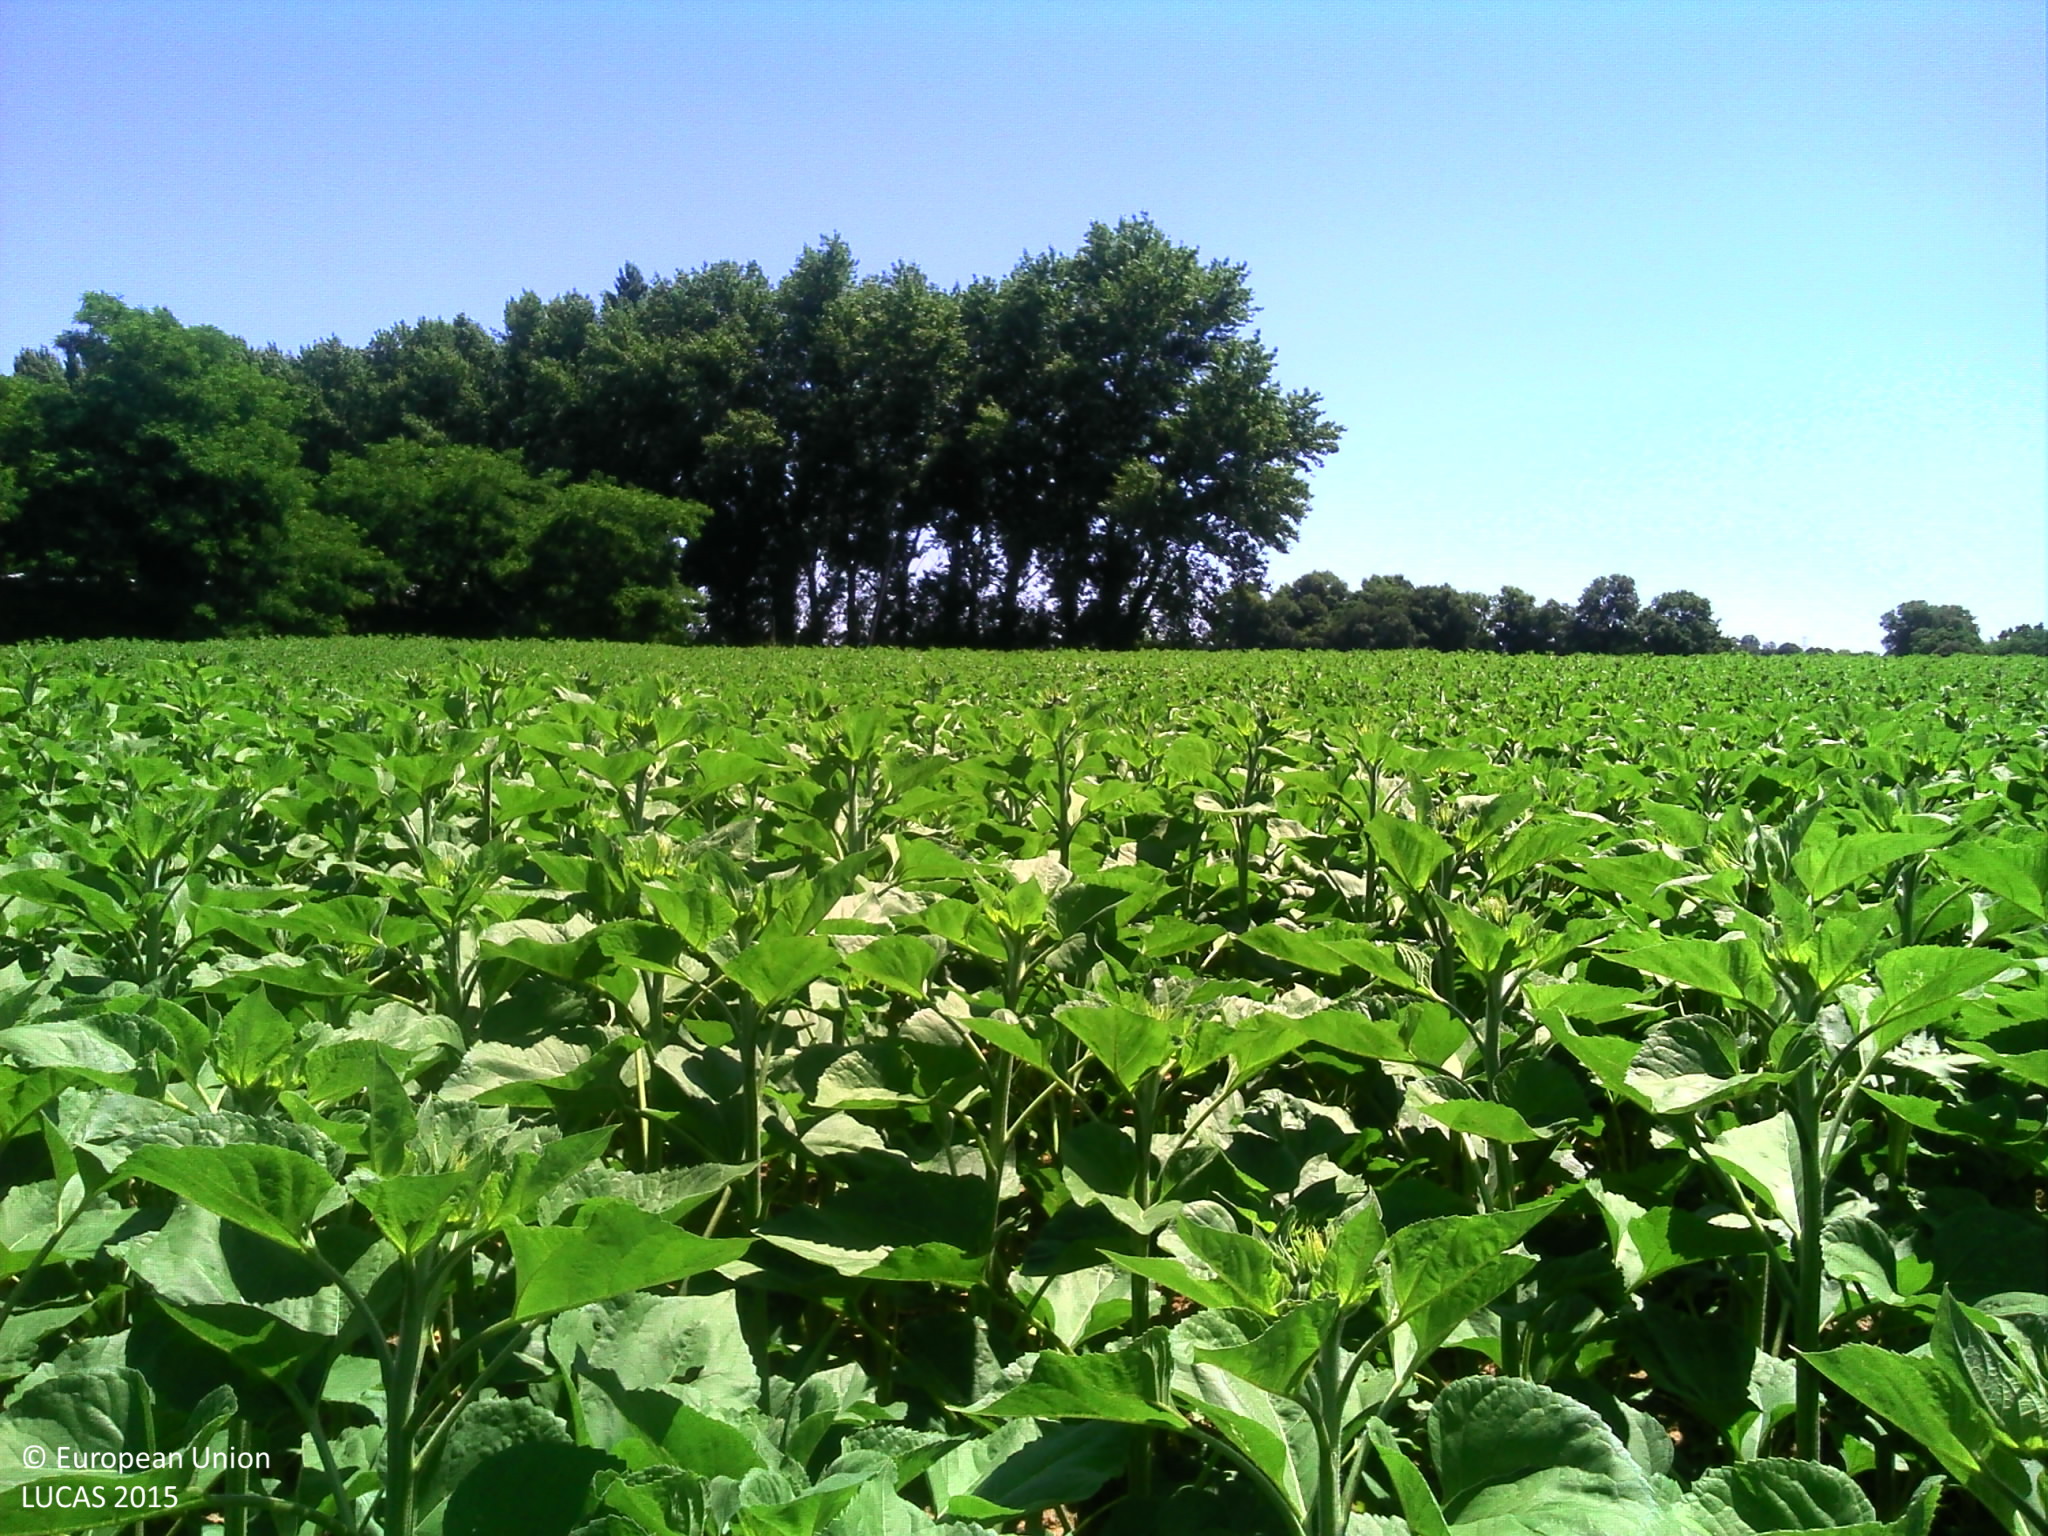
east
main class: Cropland
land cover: Sunflower
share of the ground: > 75 %
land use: Agriculture (excluding fallow land and kitchen gardens)
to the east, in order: Sunflower; Grassland with sparse tree/shrub cover; Broadleaved woodland; Sunflower; Grass margins; Paved roads, cycling and walking lanes; Grass margins; Maize
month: June
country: FR
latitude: 45.6507
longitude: -0.6875
